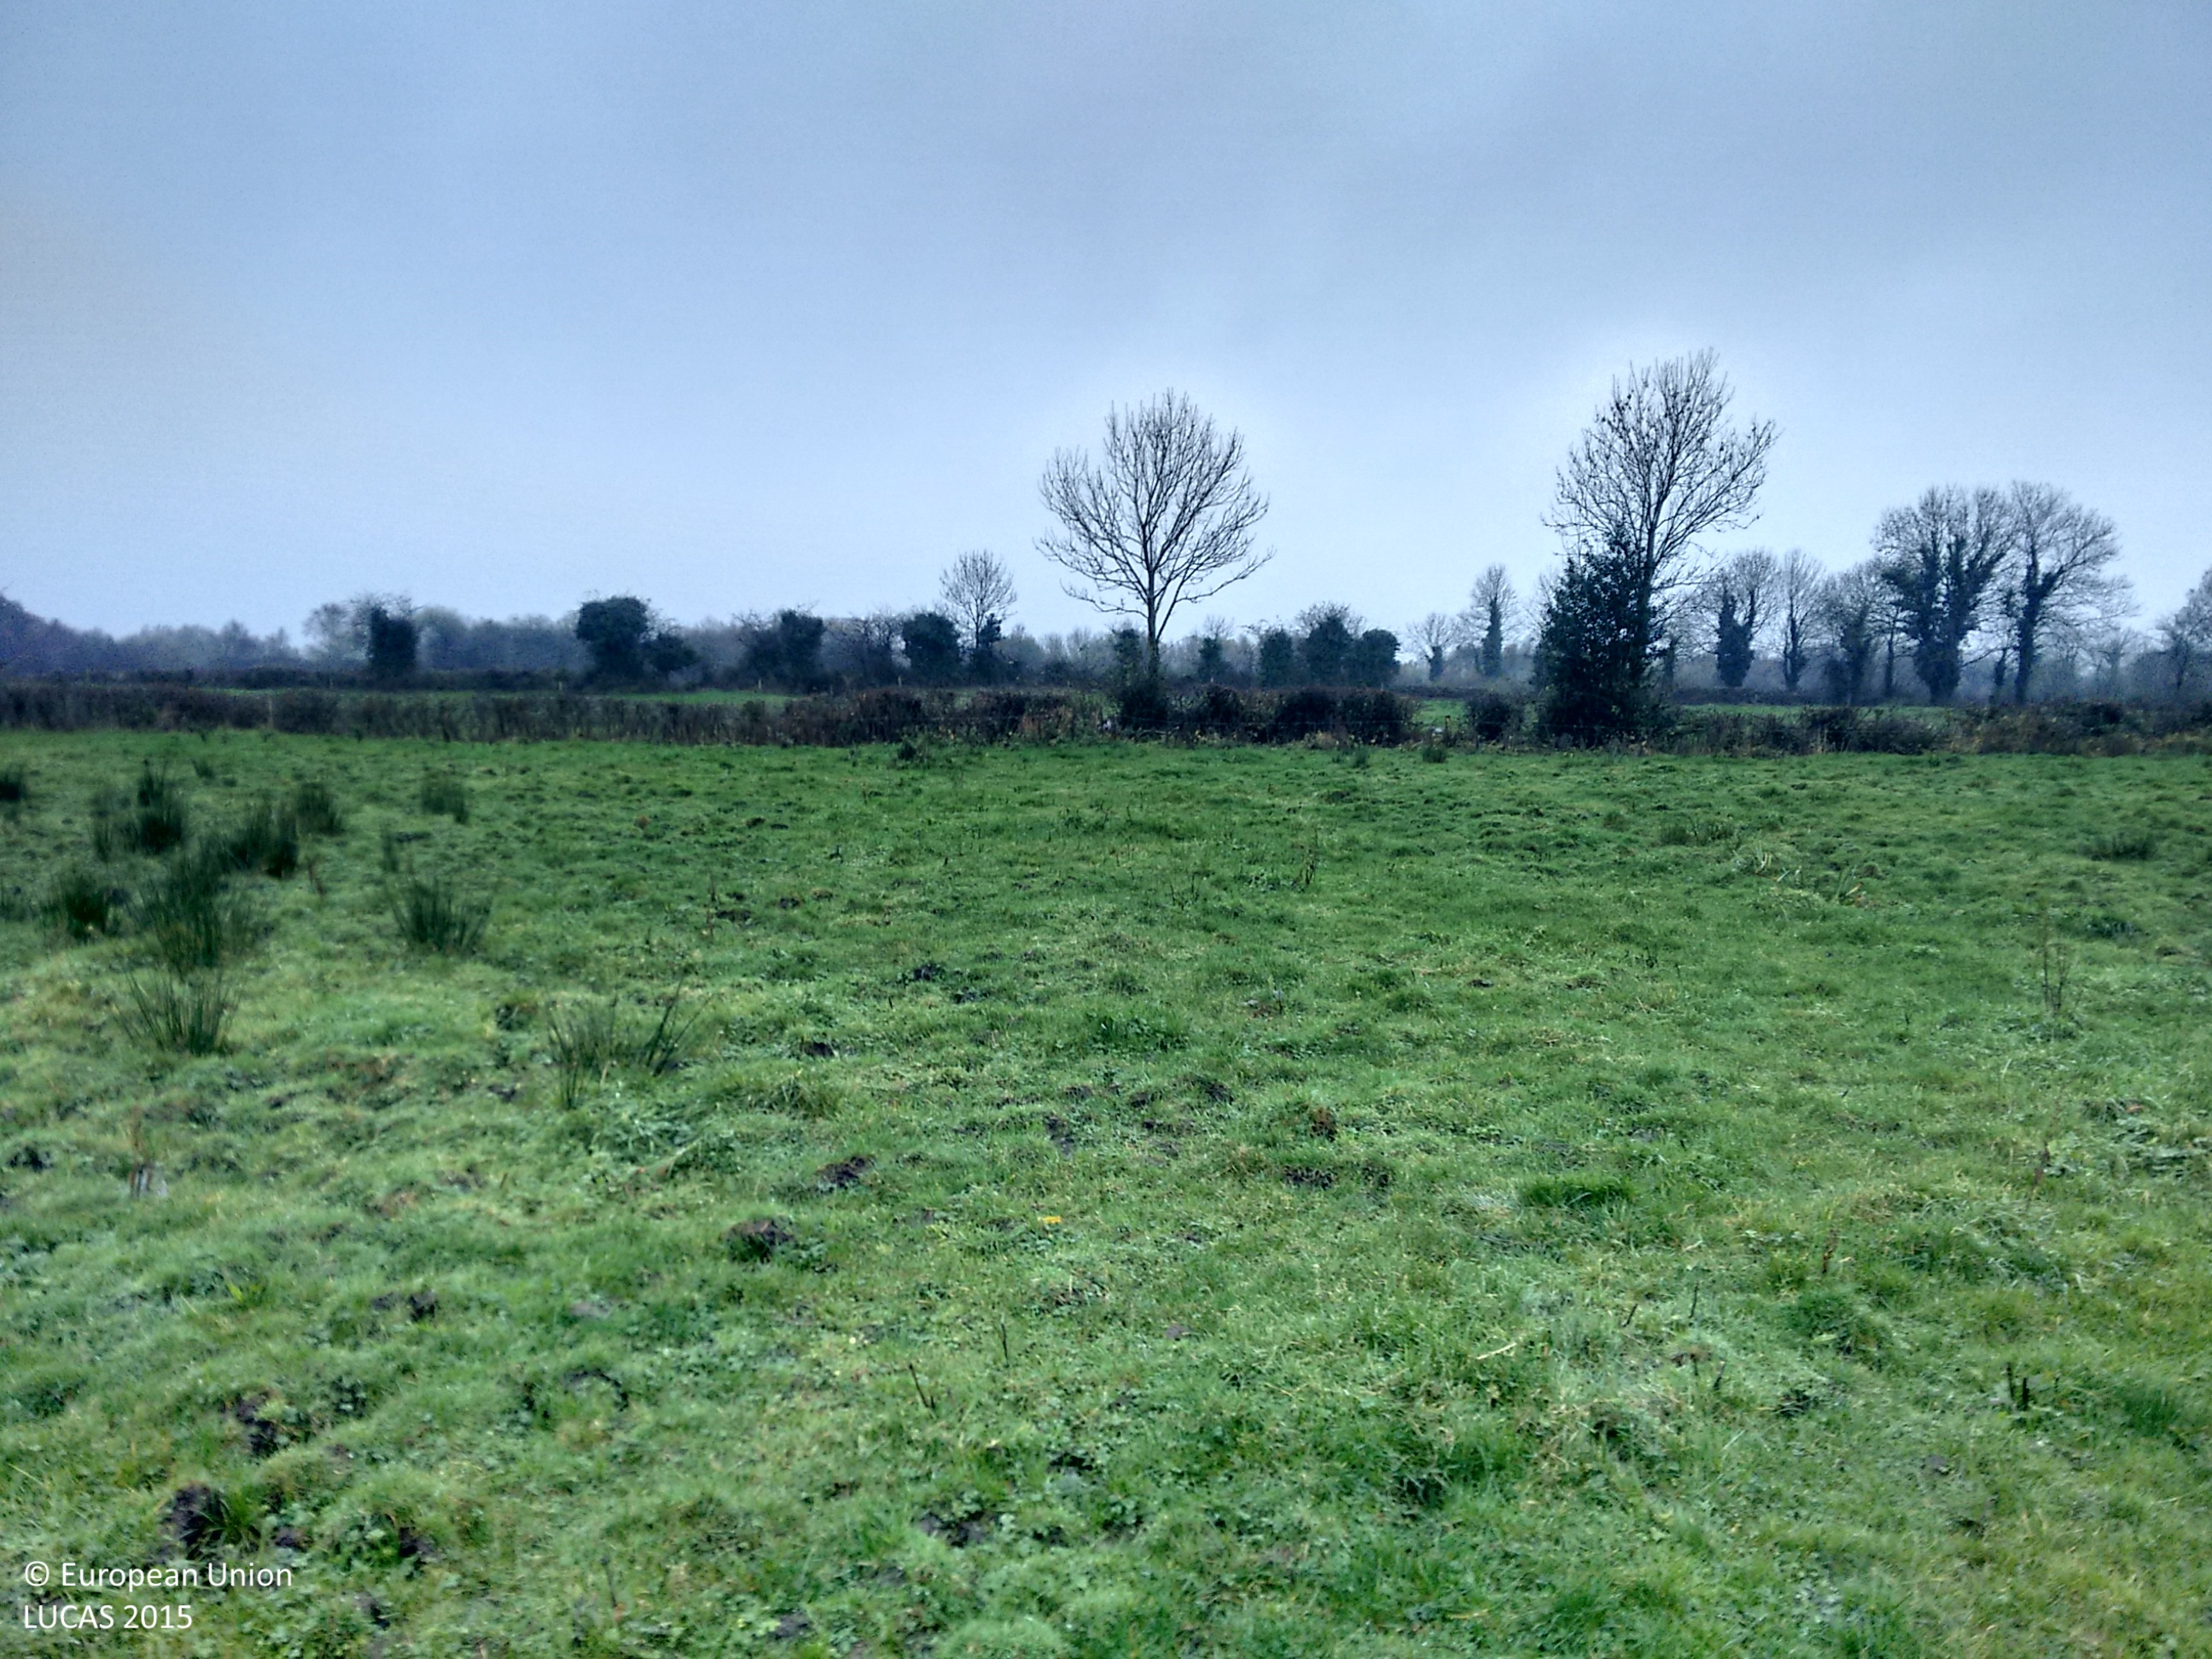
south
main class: Grassland
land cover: Grassland without tree/shrub cover
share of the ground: > 75 %
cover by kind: herbaceous plants 95 %
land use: Agriculture (excluding fallow land and kitchen gardens)
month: November
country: IE
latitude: 53.8494
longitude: -7.8477
